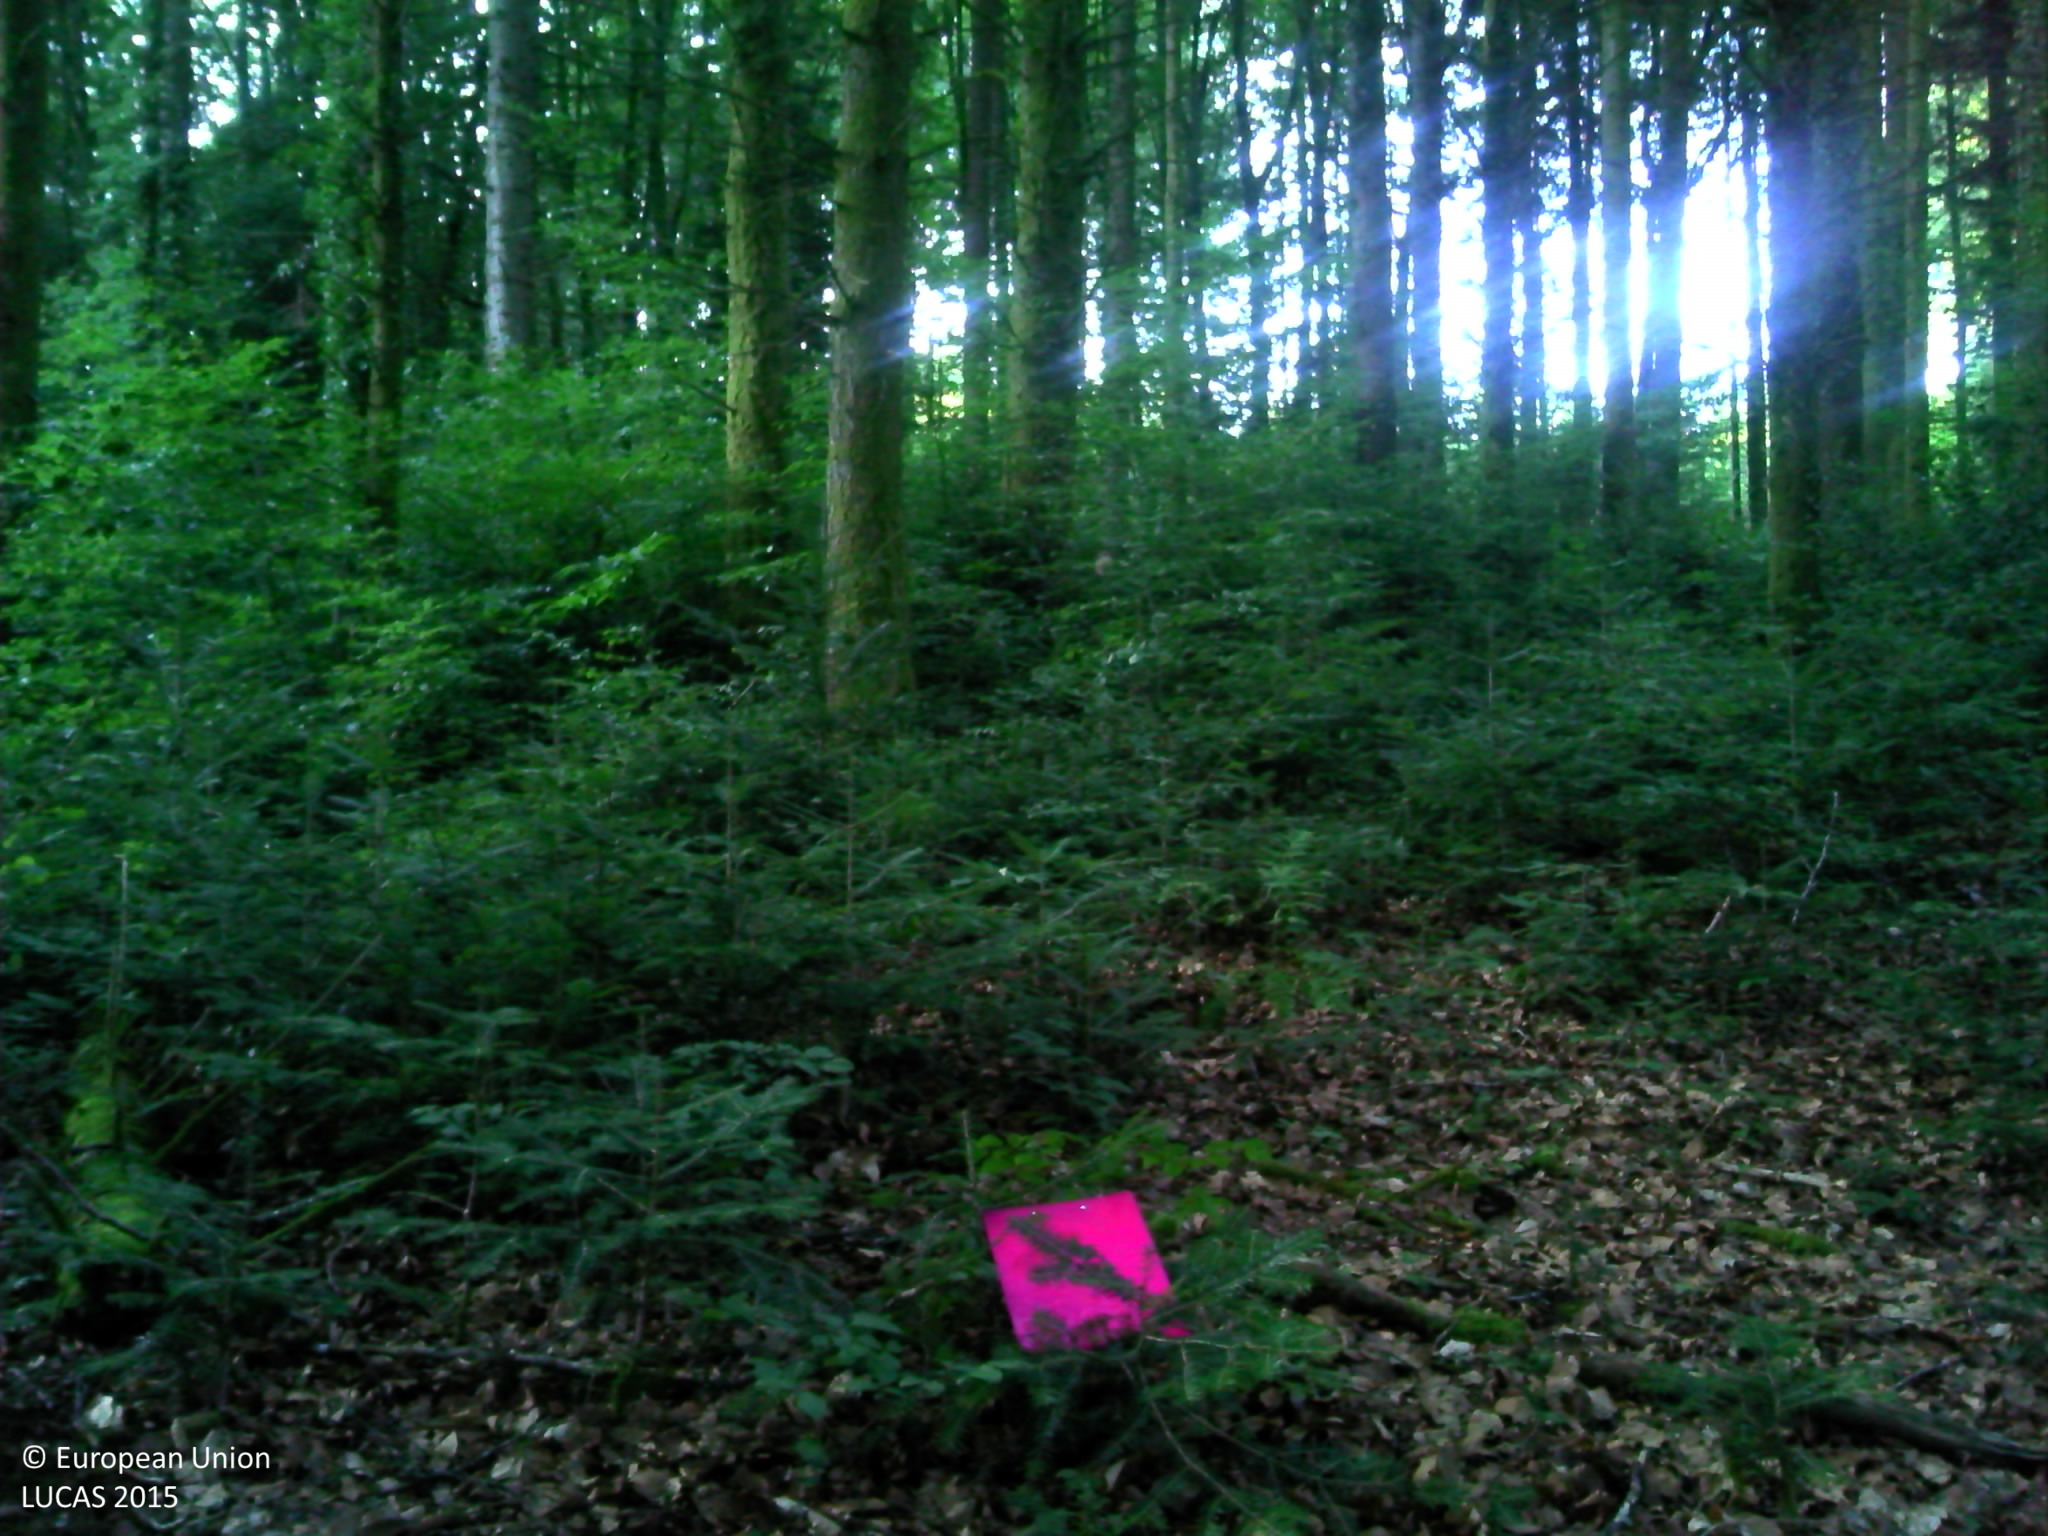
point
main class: Woodland
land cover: Other mixed woodland
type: exotic forest
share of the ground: > 75 %
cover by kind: coniferous forest trees 60 %, broadleaved forest trees 25 %, shrubs 5 %, herbaceous plants 5 %, lichens and mosses 5 %
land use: Forestry
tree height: > 5 m
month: August
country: FR
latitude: 45.8900
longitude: 1.7847
